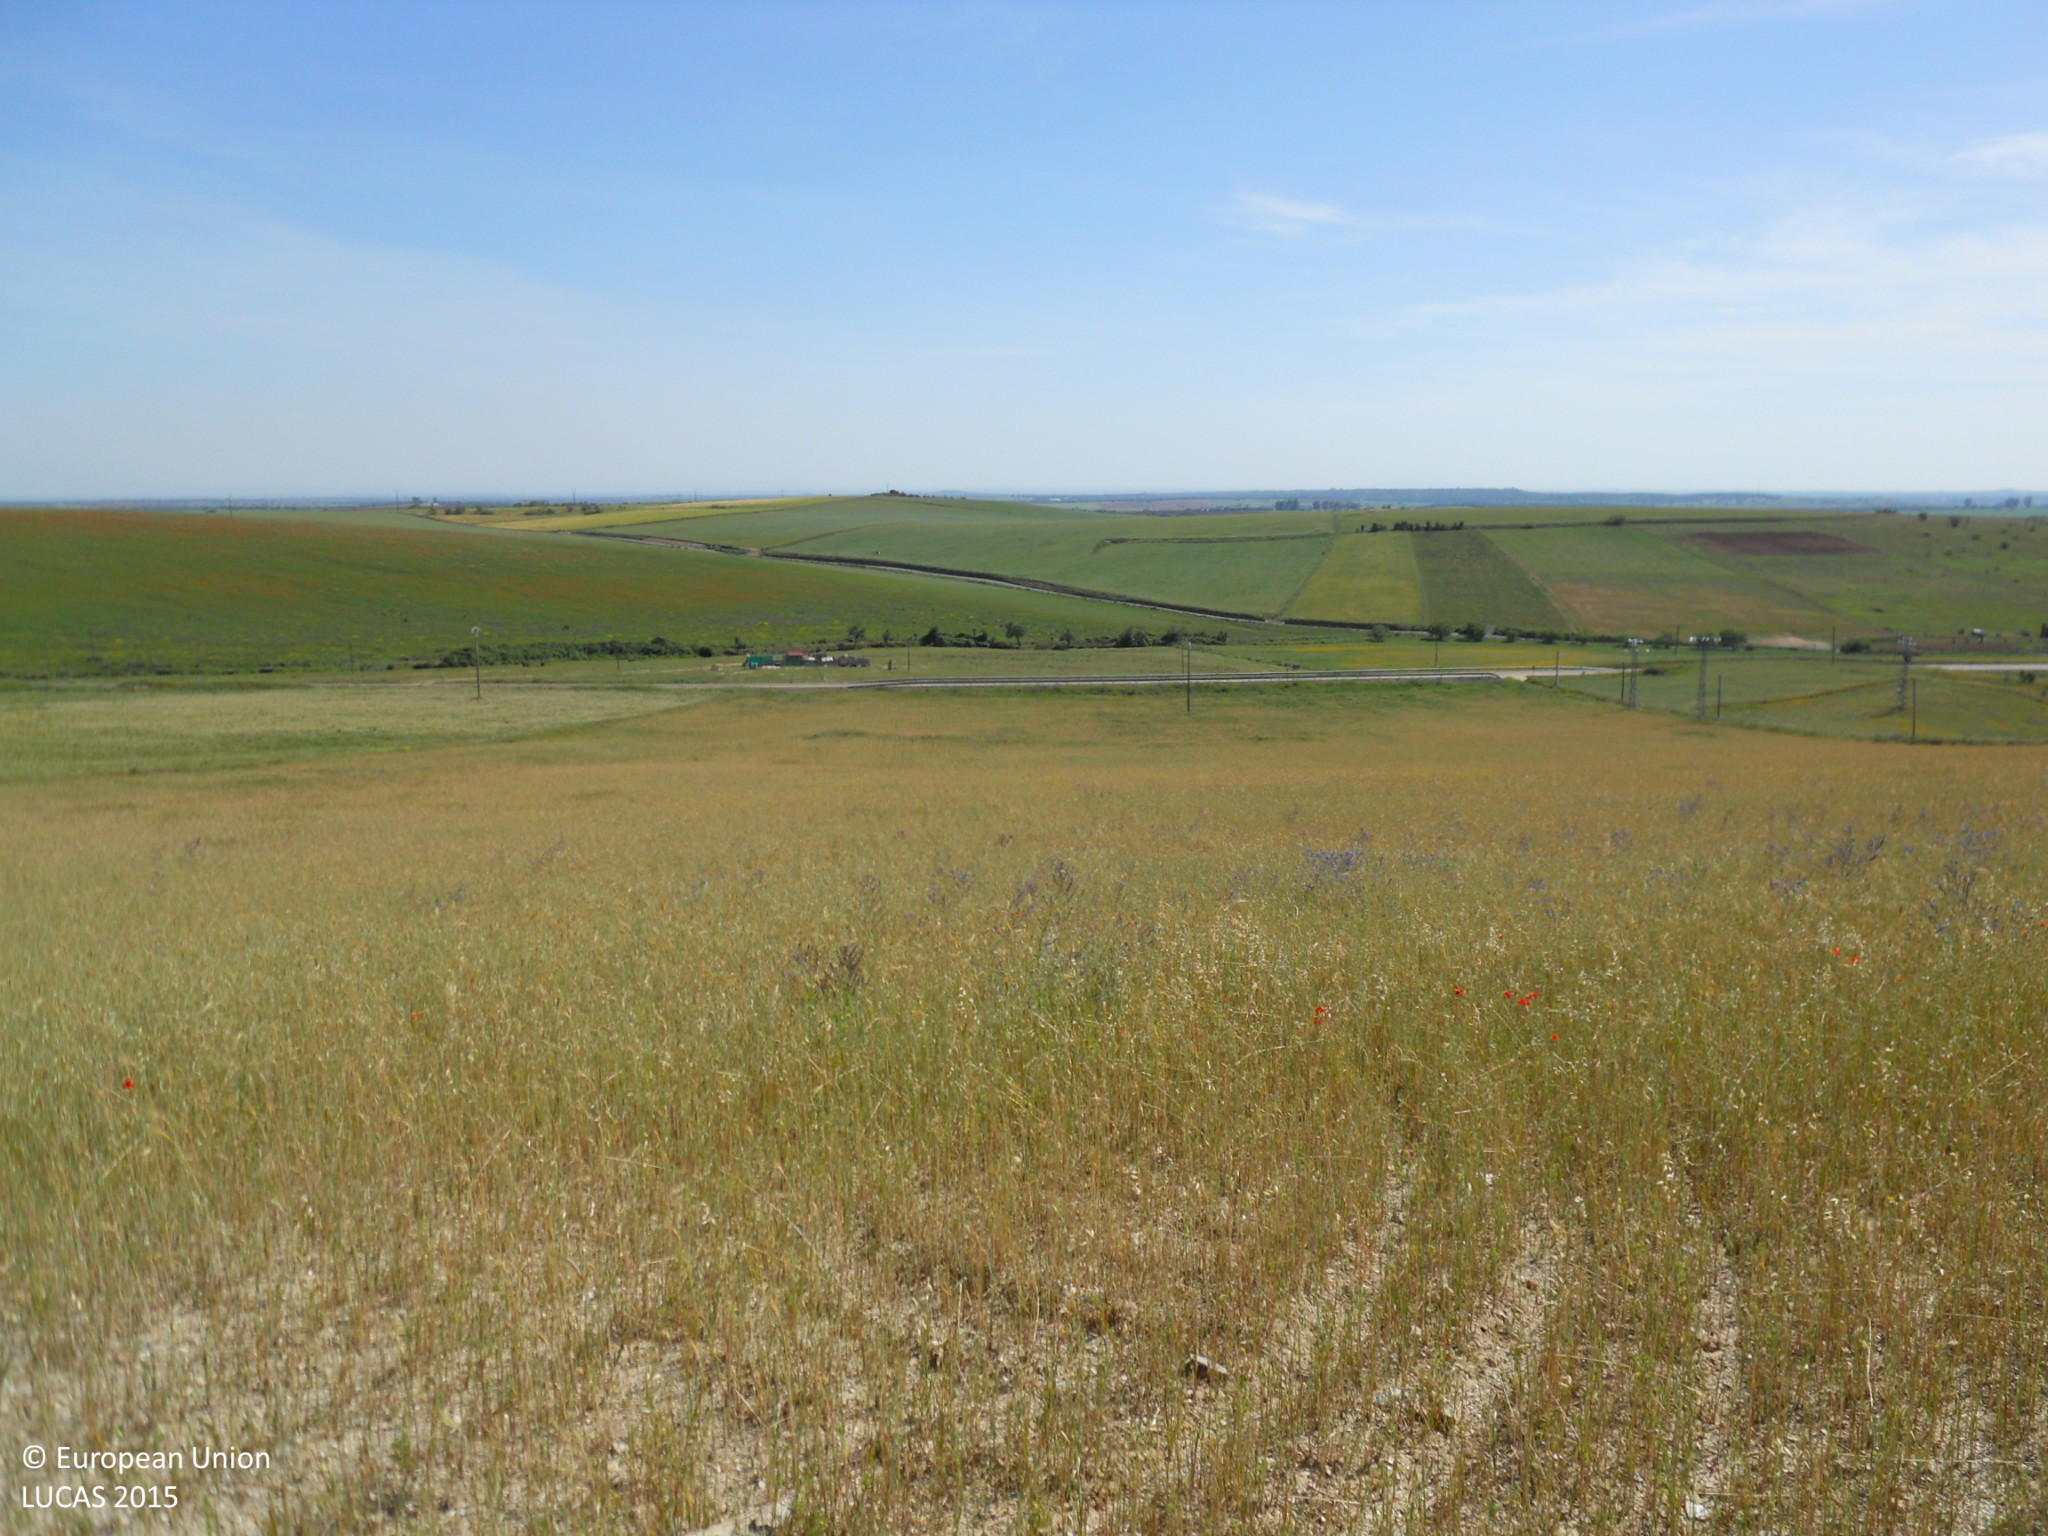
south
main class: Cropland
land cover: Mixed cereals for fodder
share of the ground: > 75 %
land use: Agriculture (excluding fallow land and kitchen gardens)
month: April
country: ES
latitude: 39.1328
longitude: -6.8341
